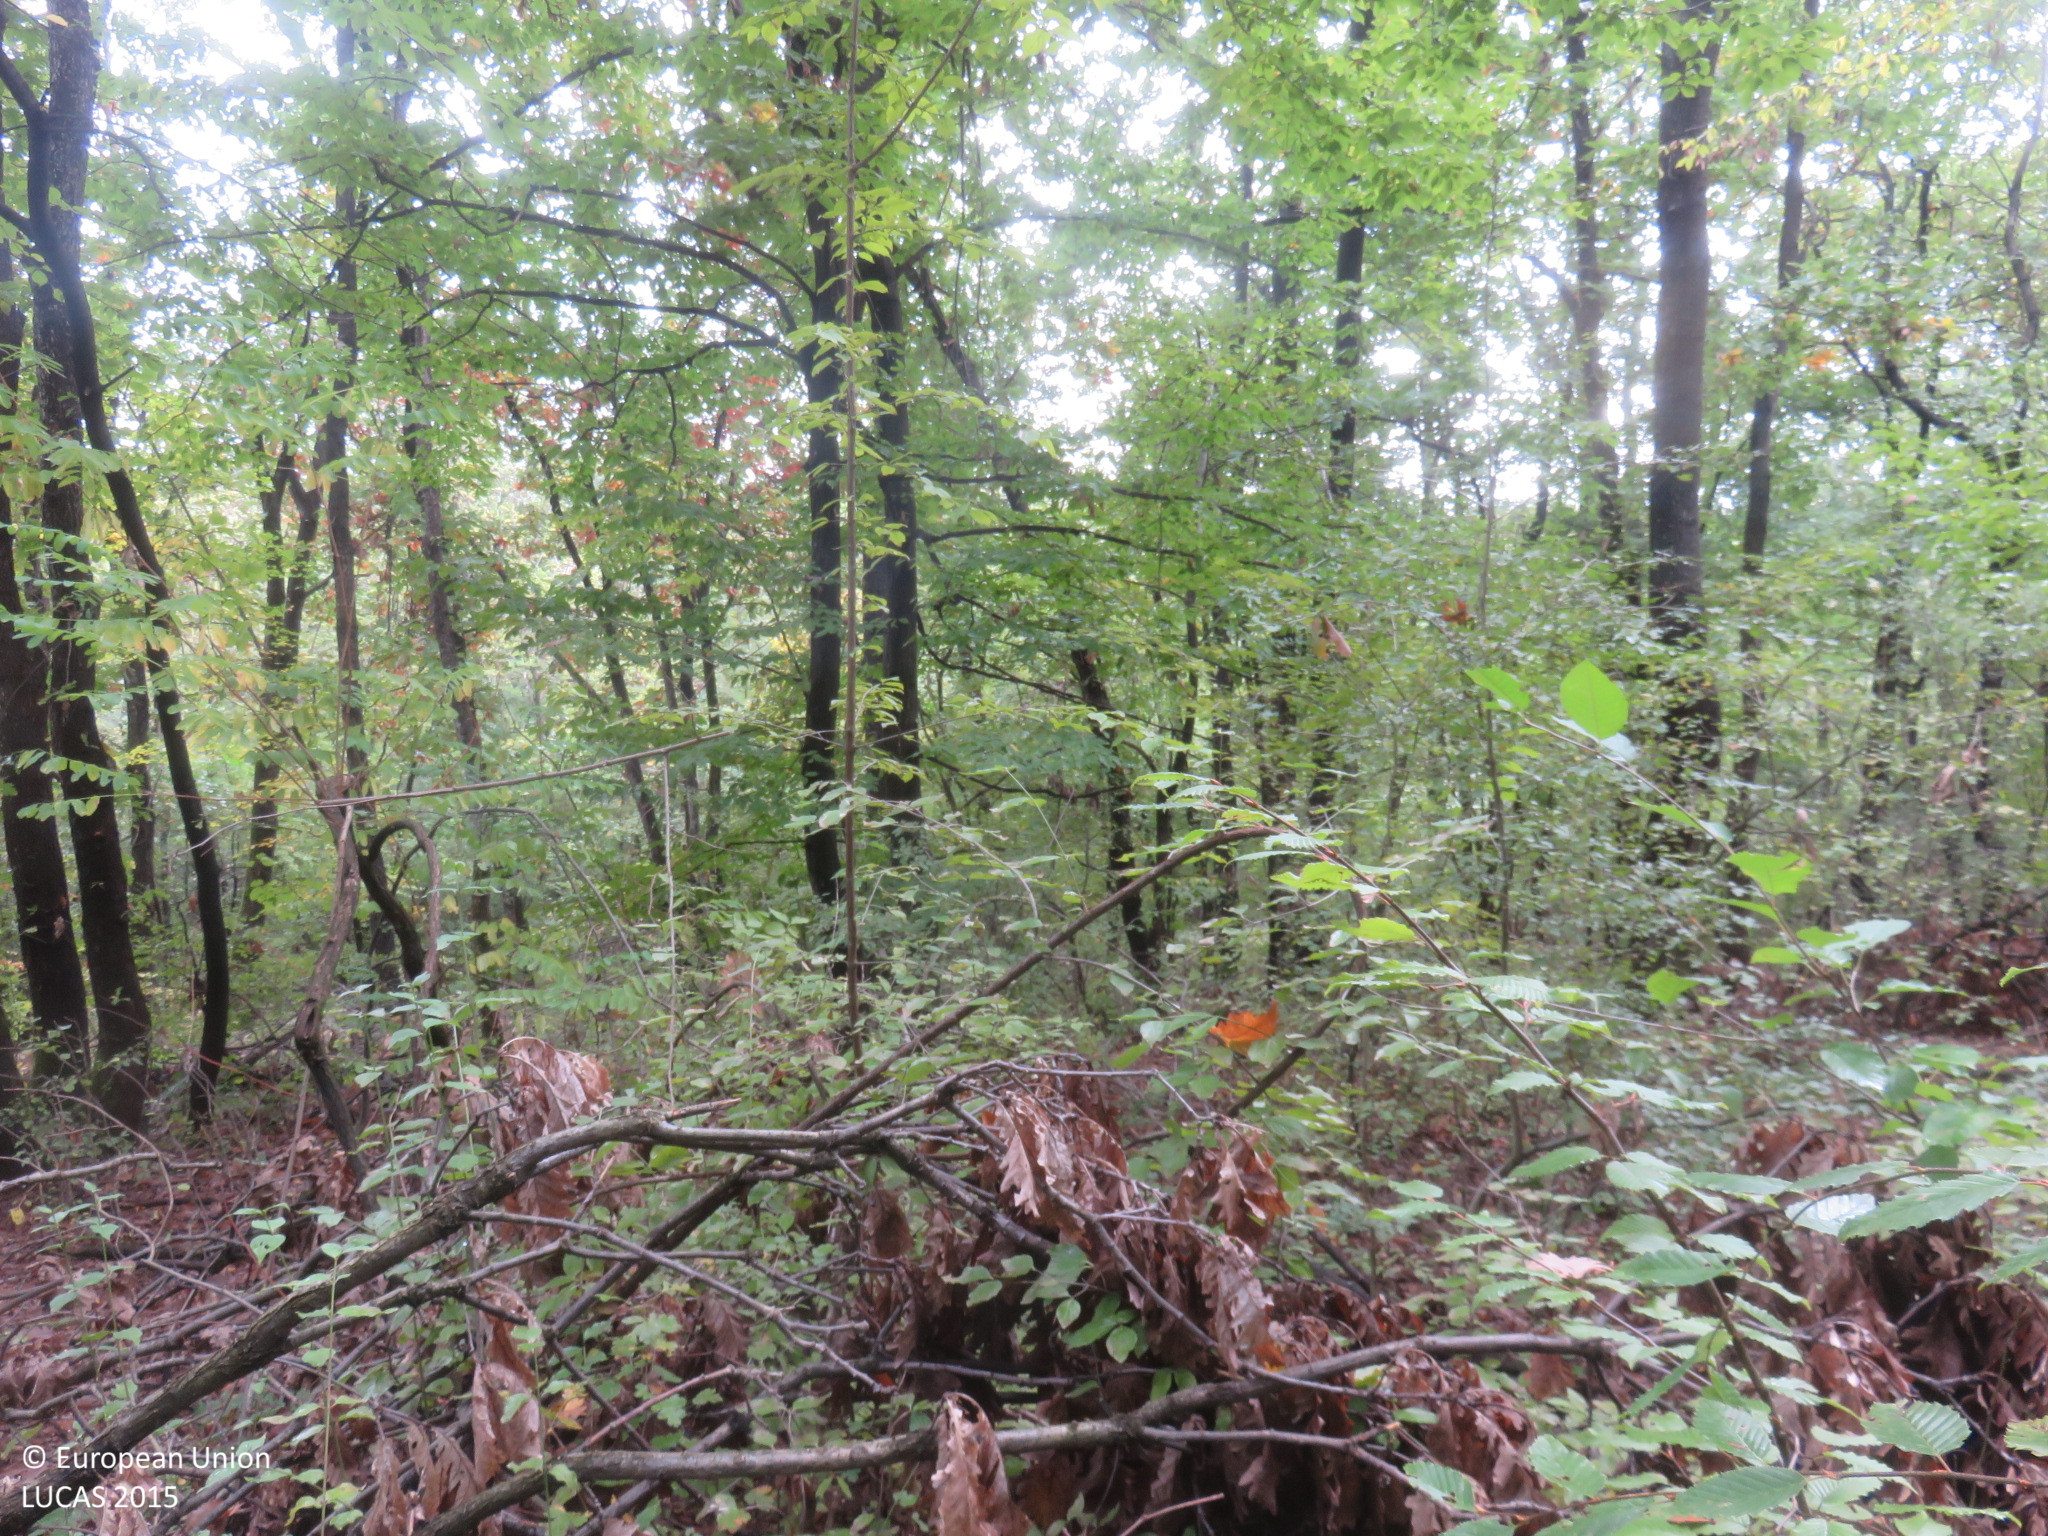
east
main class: Woodland
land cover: Broadleaved woodland
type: mesophytic deciduous forest
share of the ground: > 75 %
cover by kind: broadleaved forest trees 95 %, shrubs 5 %
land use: Forestry
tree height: < 5 m
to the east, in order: Broadleaved woodland; Shrubland with sparse tree cover; Other bare soil
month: October
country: BG
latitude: 43.0566
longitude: 25.2094
